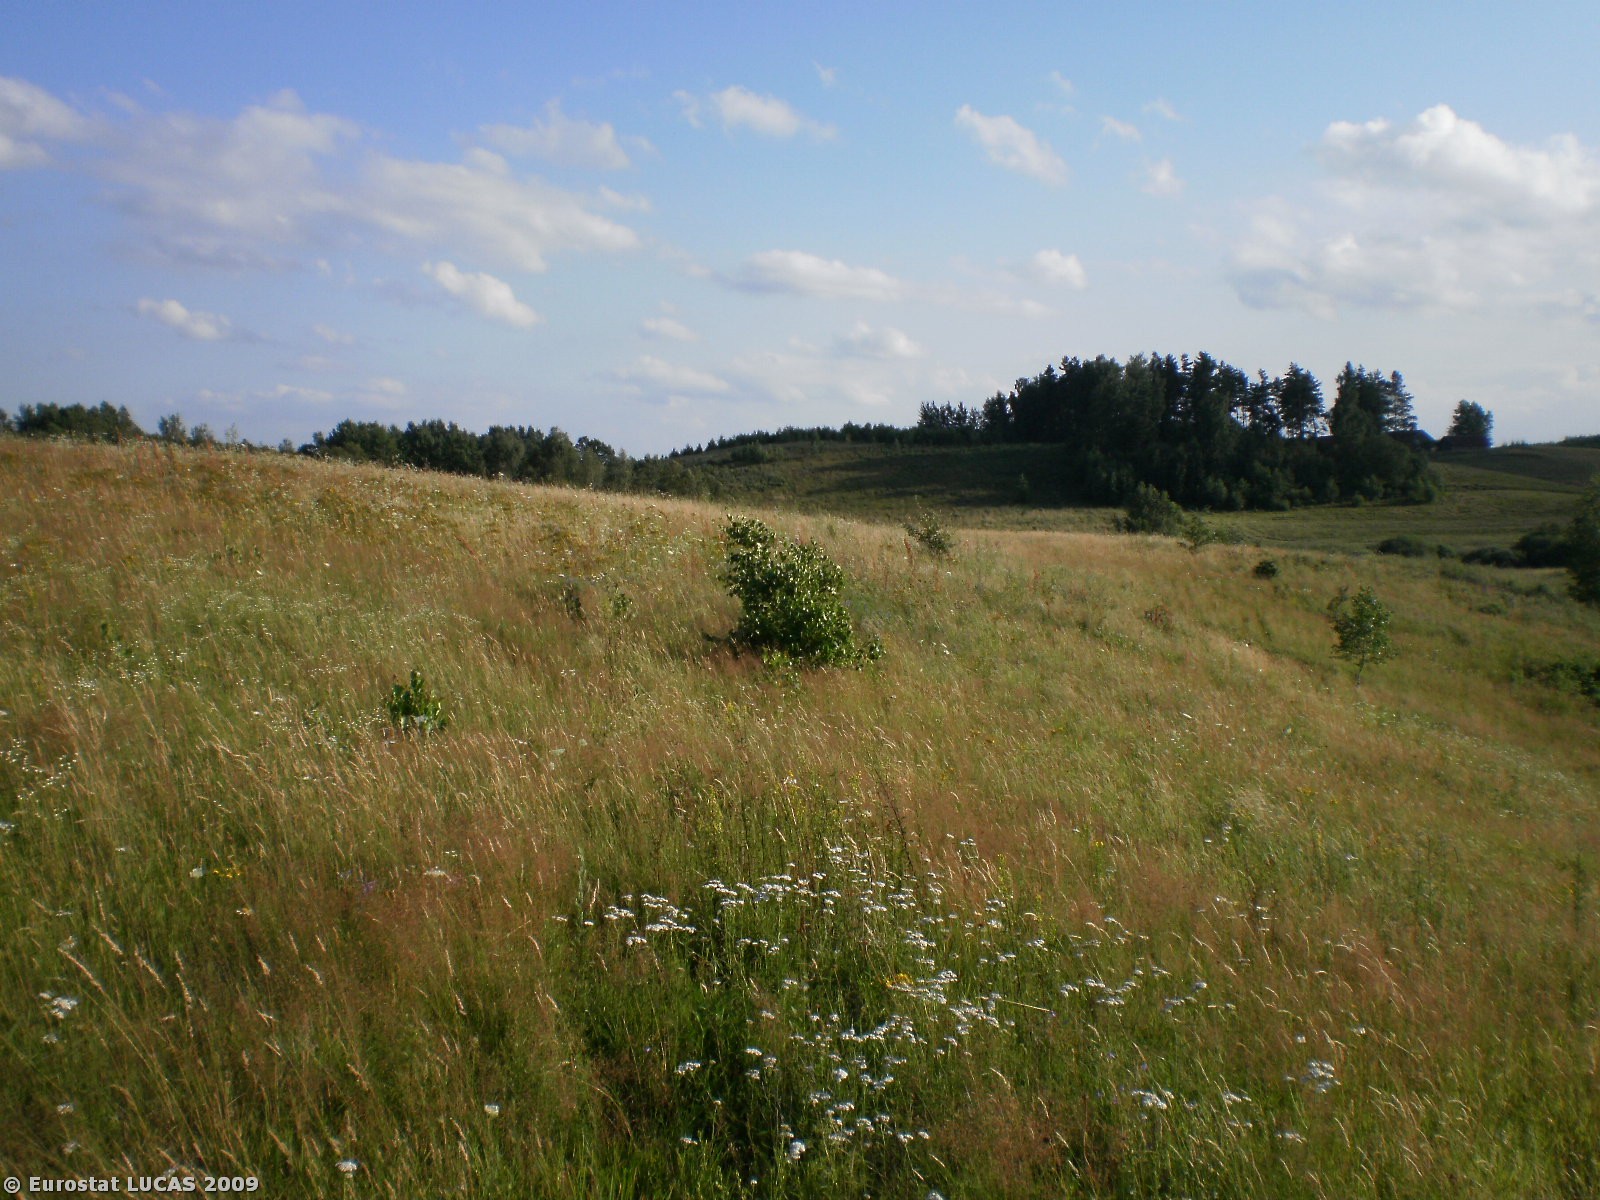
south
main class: Grassland
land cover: Grassland with sparse tree/shrub cover
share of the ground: > 75 %
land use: Unused
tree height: > 5 m
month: July
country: PL
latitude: 53.9691
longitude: 20.6021
